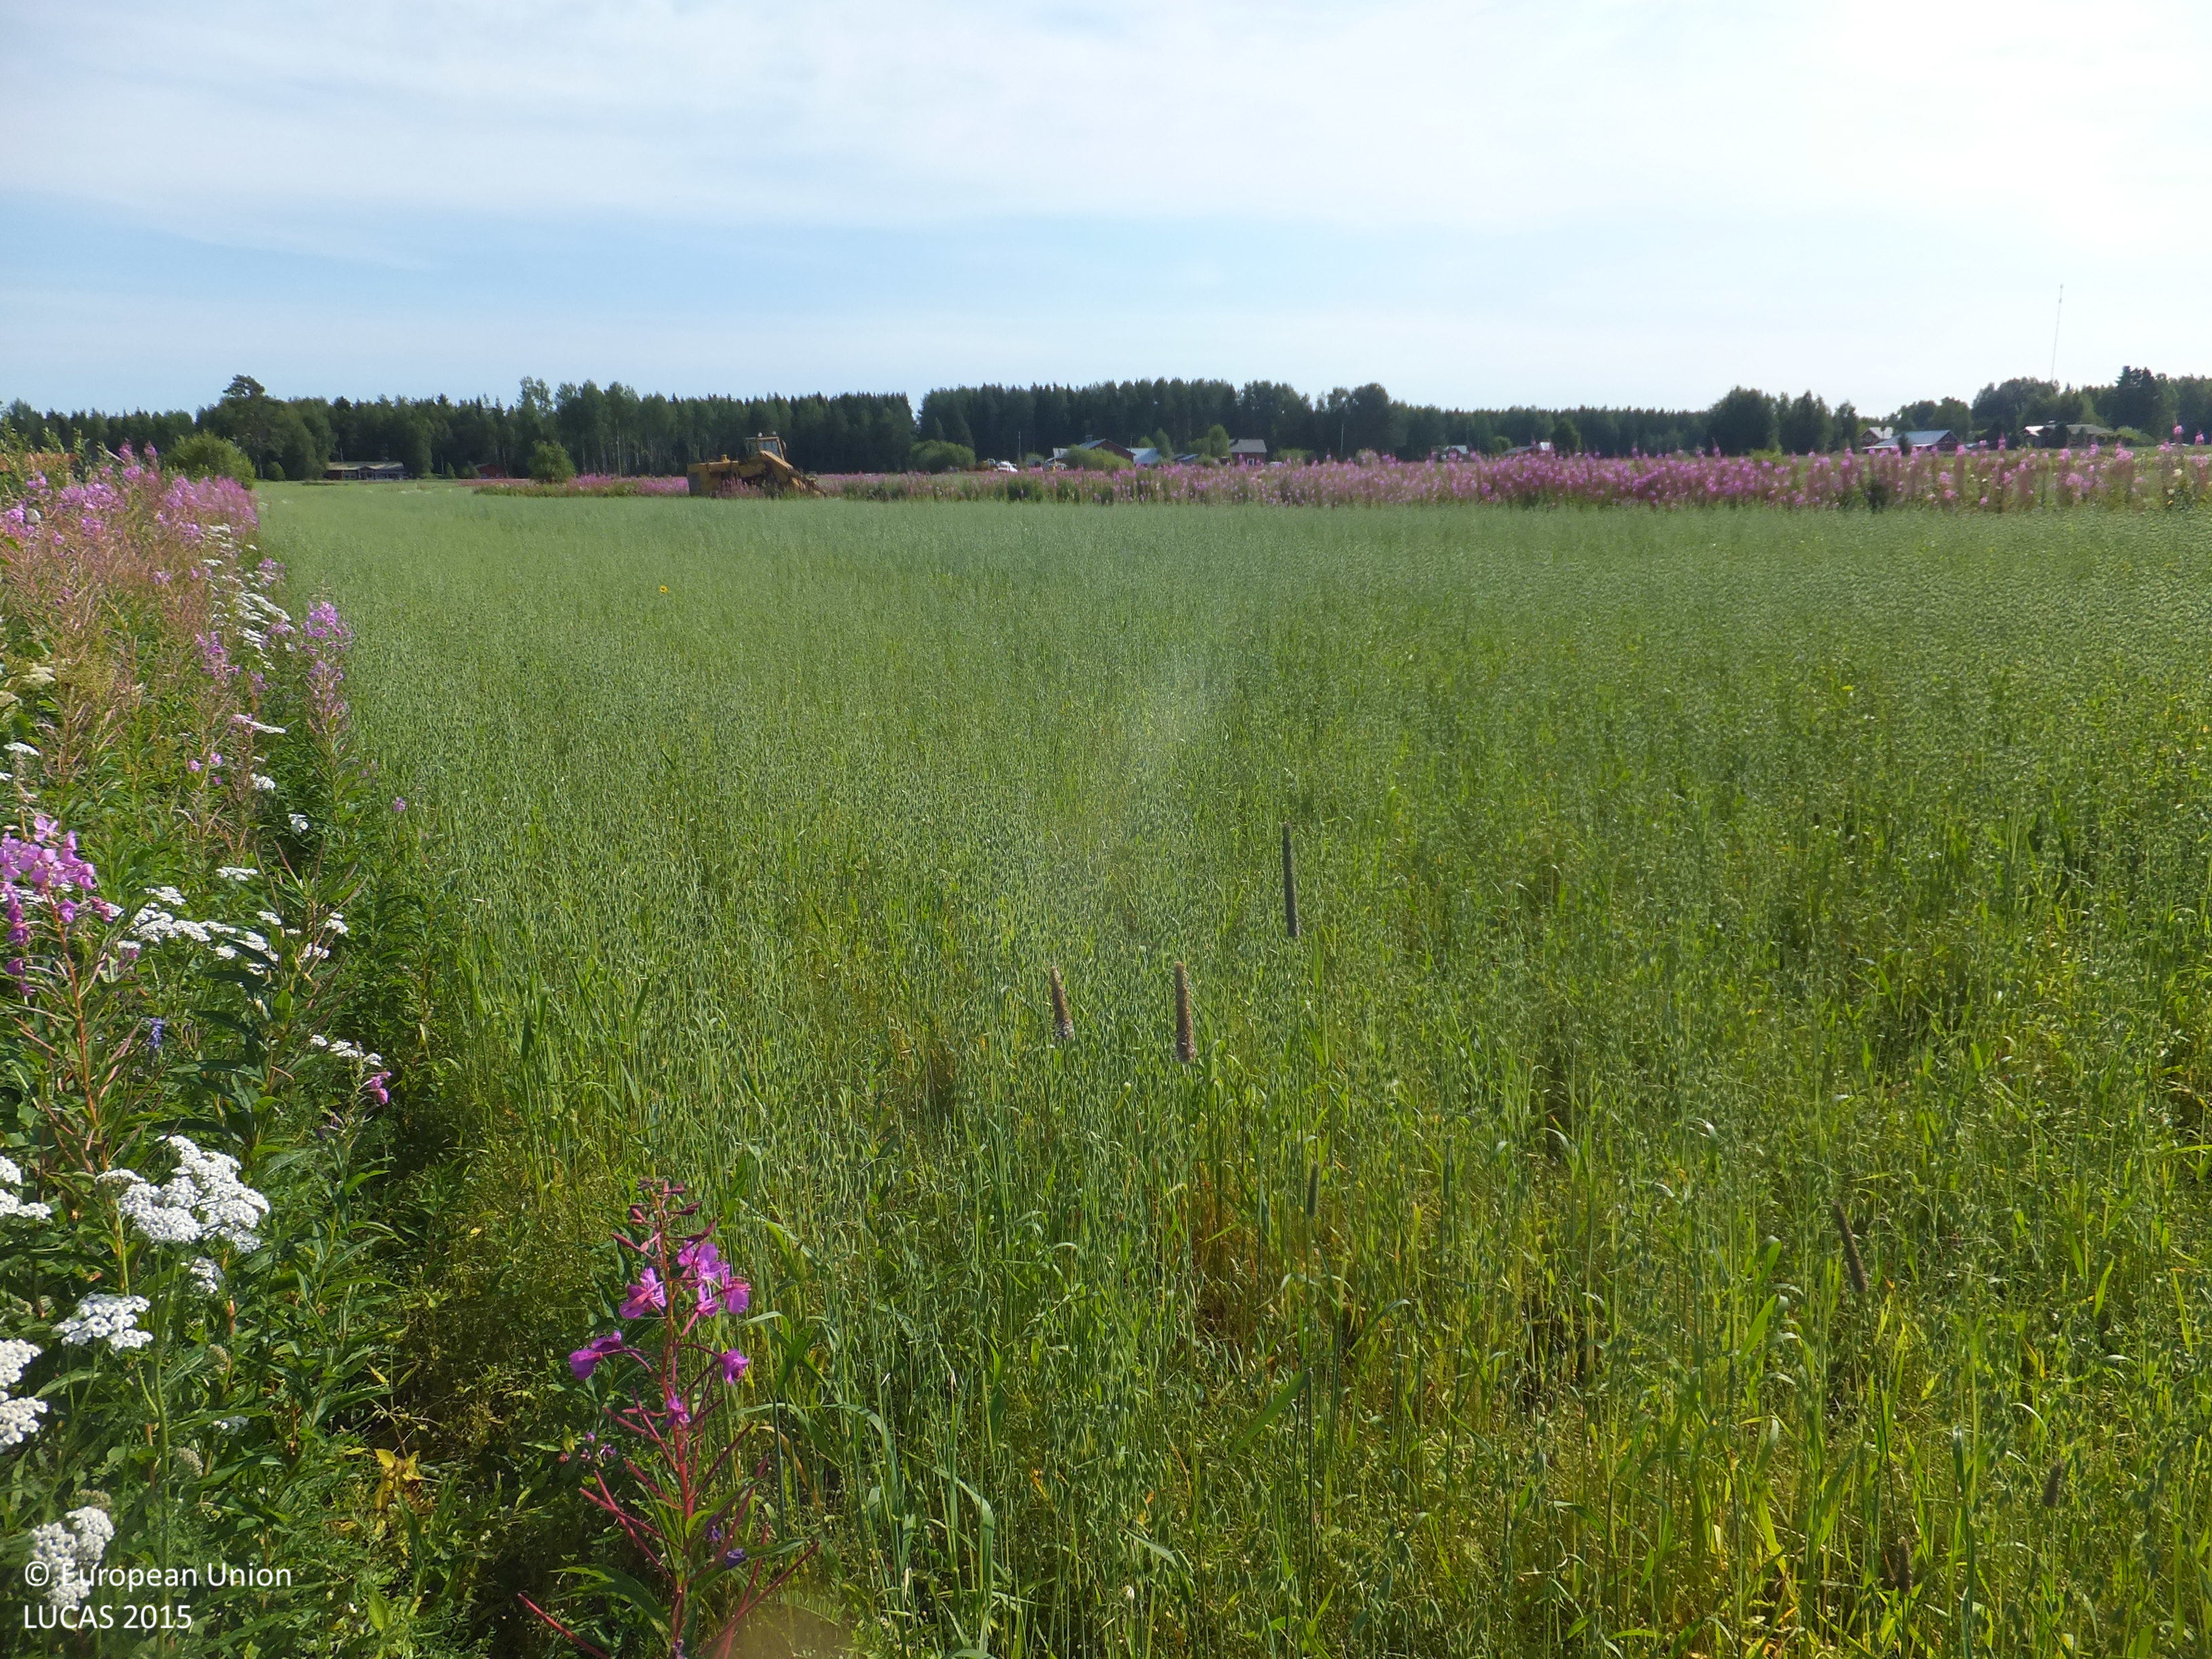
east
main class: Cropland
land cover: Oats
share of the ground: 50 - 75 %
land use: Agriculture (excluding fallow land and kitchen gardens)
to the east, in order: Oats; Grass margins; Ditches and canals; Grass margins; Oats; Grass margins; Ditches and canals; Grass margins; Oats; Grass margins; Ditches and canals; Grass margins; Oats; Grass margins; Ditches and canals; Grass margins; Oats; Grass margins; Ditches and canals; Grass margins; Oats; Grass margins
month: August
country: FI
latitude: 63.3165
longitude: 22.9290
